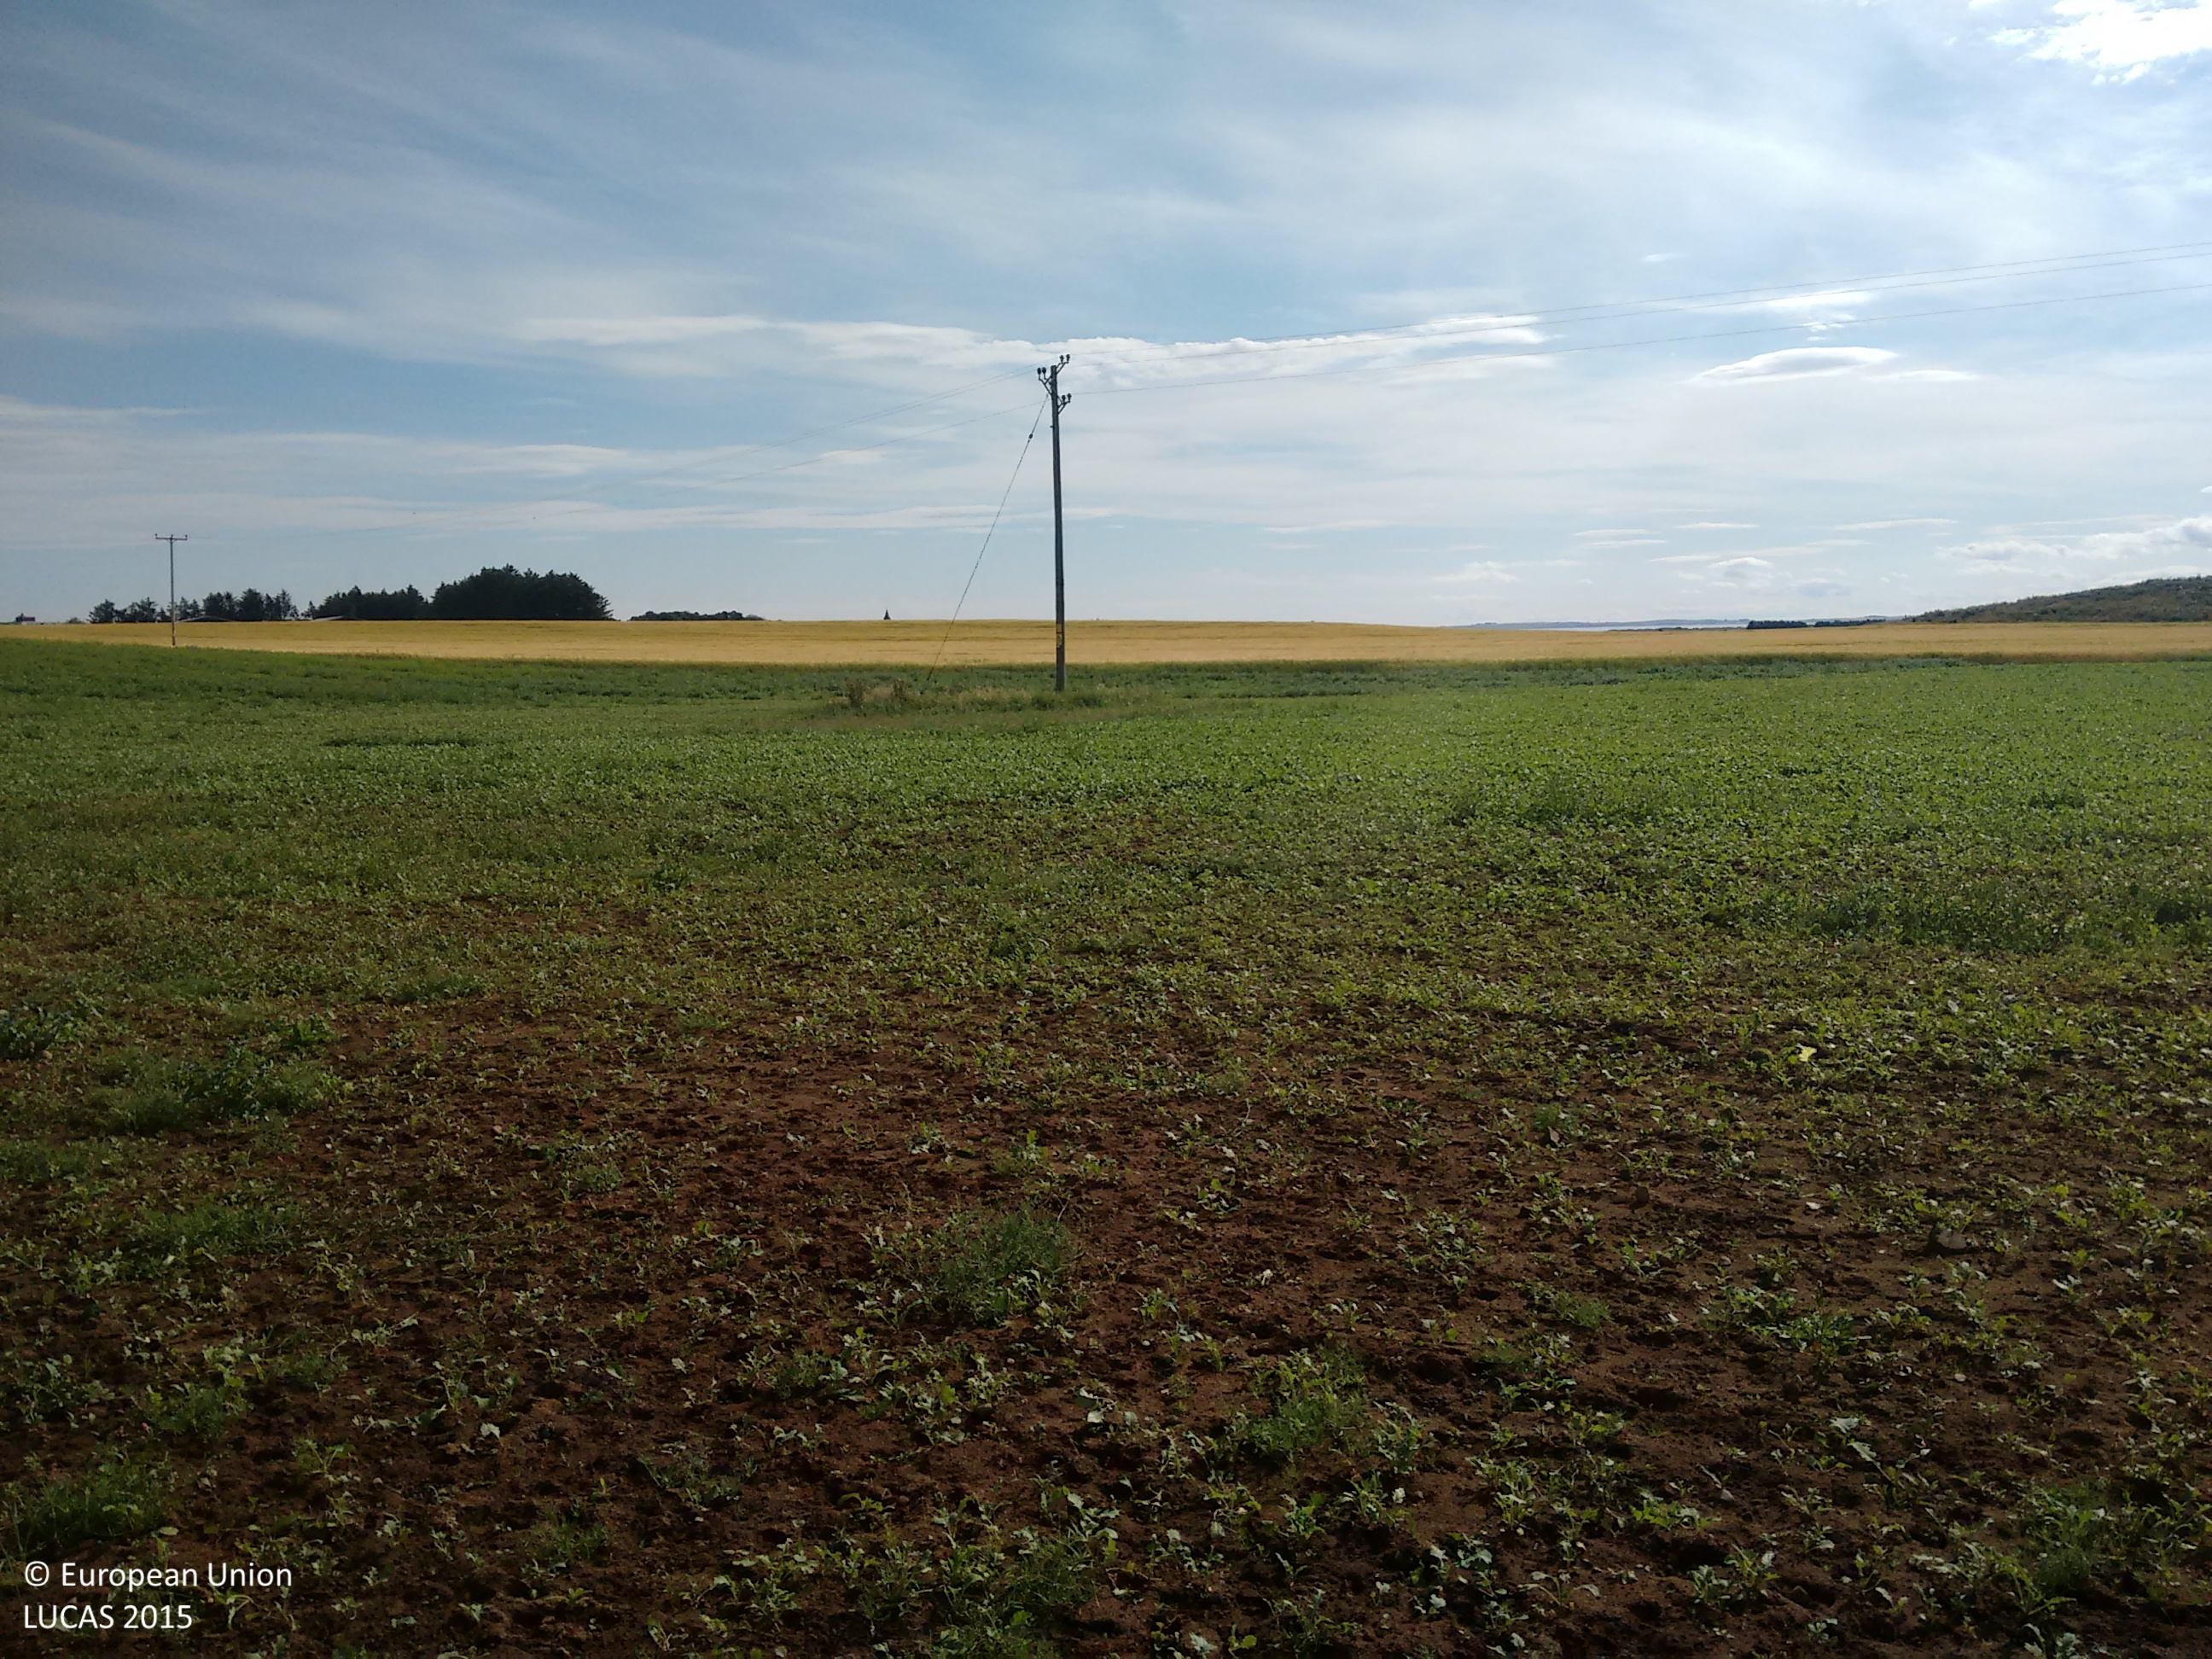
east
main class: Grassland
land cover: Spontaneously vegetated surfaces
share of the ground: 50 - 75 %
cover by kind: herbaceous plants 75 %, unconsolidated bare surface 25 %
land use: Agriculture (excluding fallow land and kitchen gardens)
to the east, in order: Spontaneously vegetated surfaces; Electric lines; Spontaneously vegetated surfaces; Barley
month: August
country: GB
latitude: 57.8781
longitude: -4.0580
